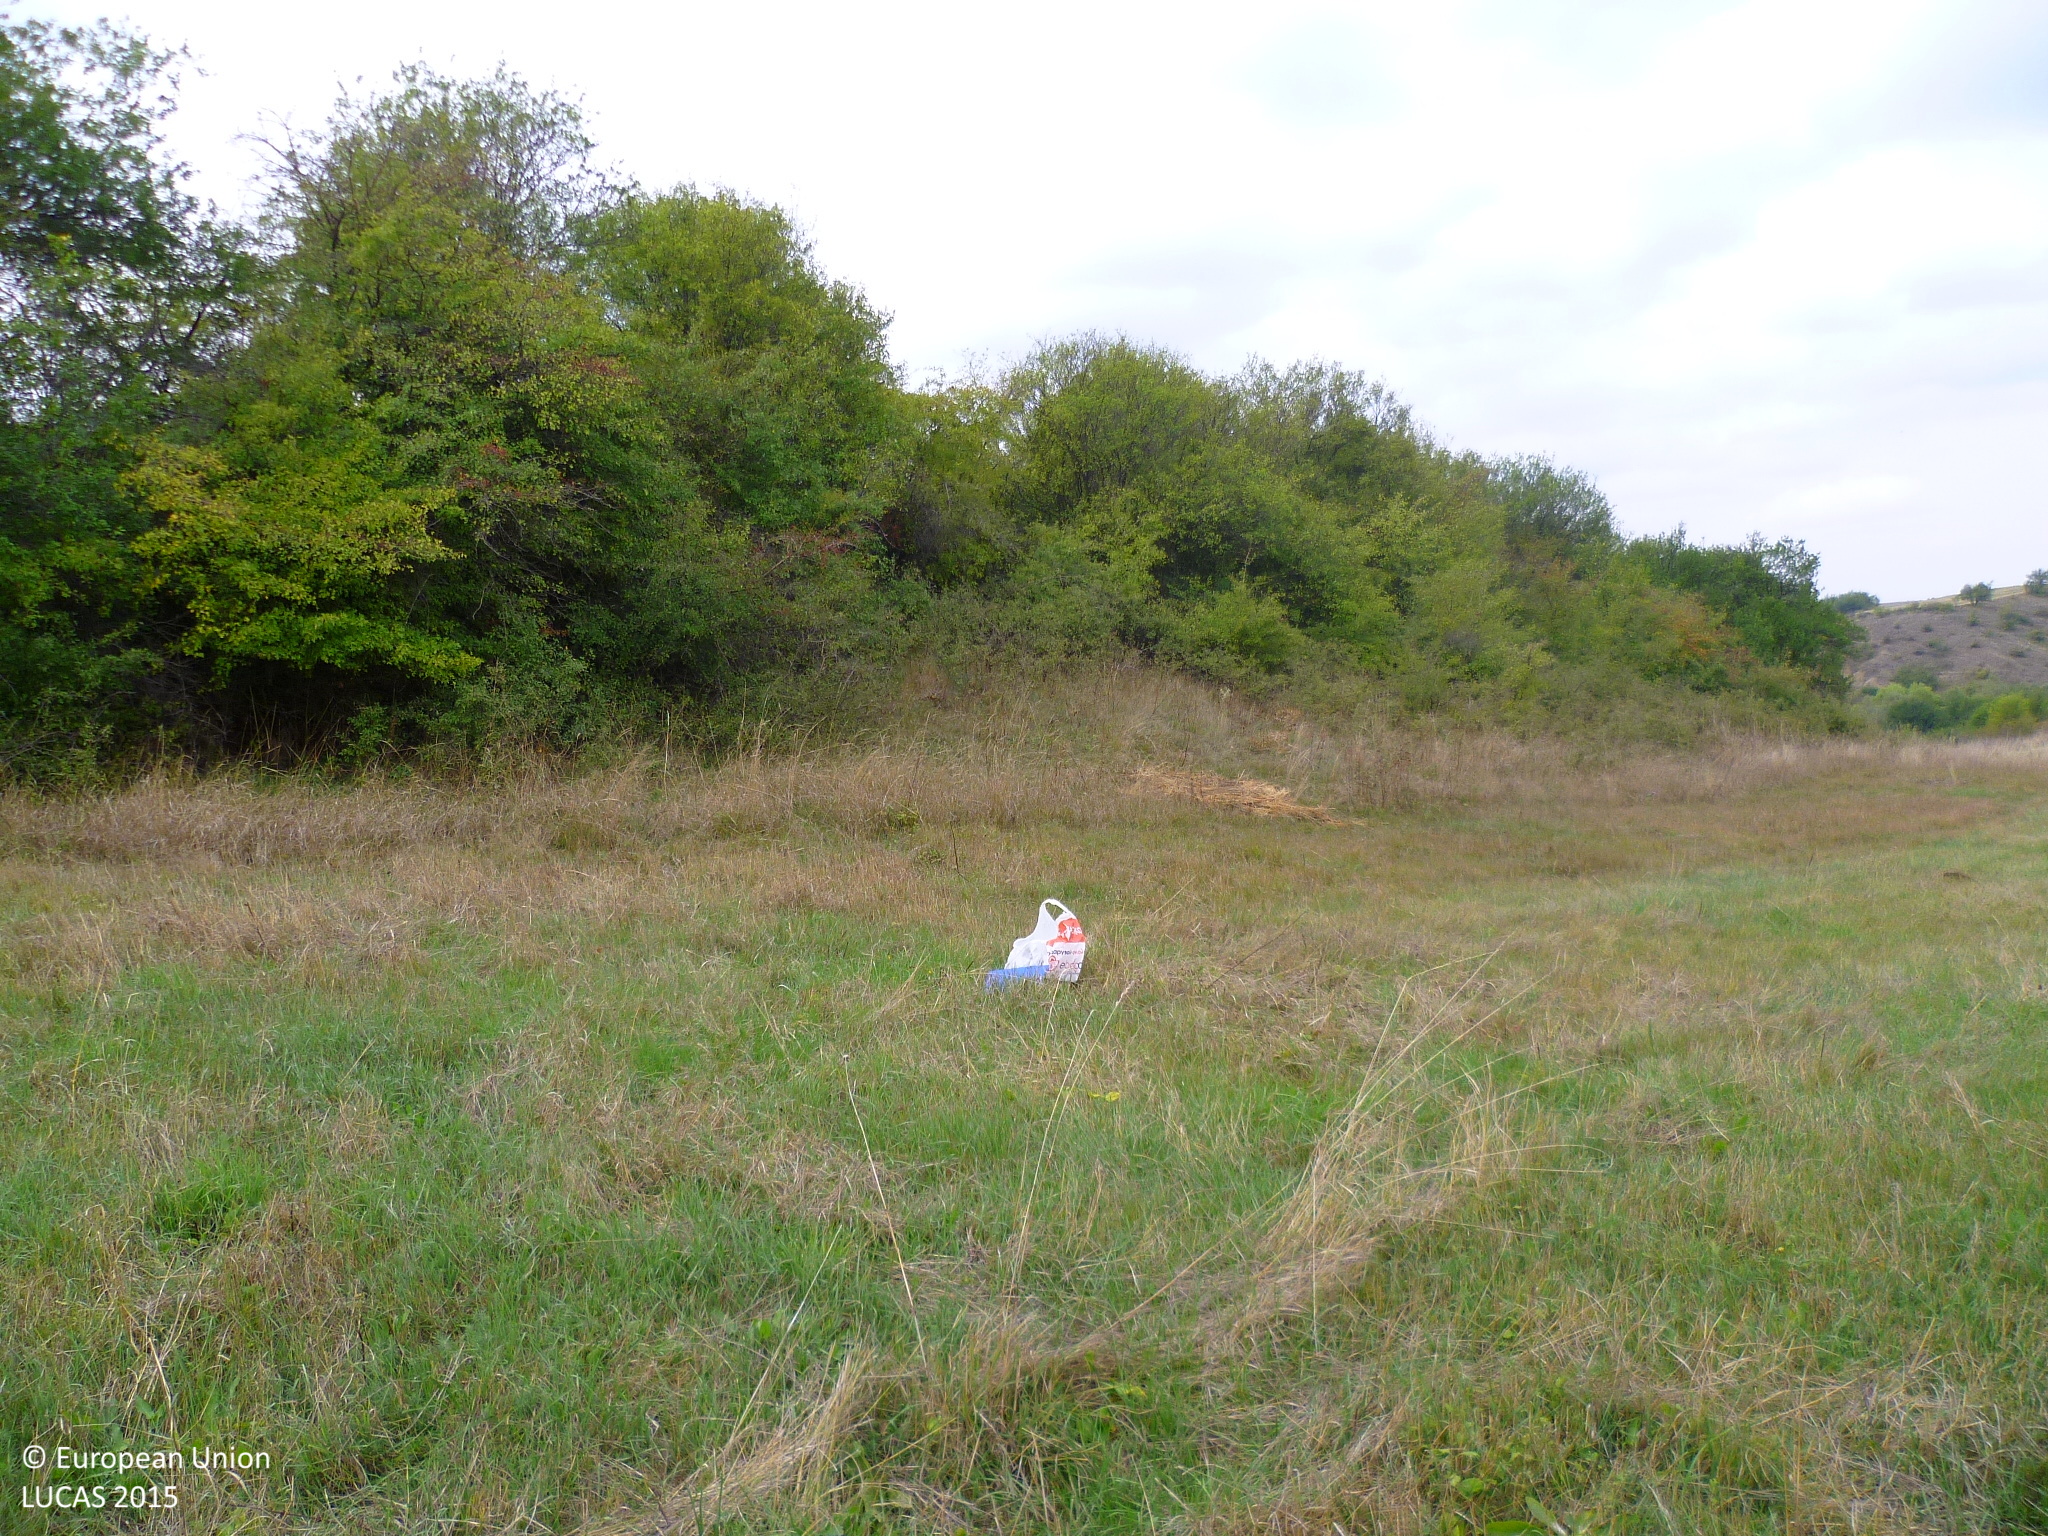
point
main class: Grassland
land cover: Grassland without tree/shrub cover
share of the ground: > 75 %
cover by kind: herbaceous plants 100 %
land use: Agriculture (excluding fallow land and kitchen gardens)
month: September
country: BG
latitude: 42.7658
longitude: 22.9715
